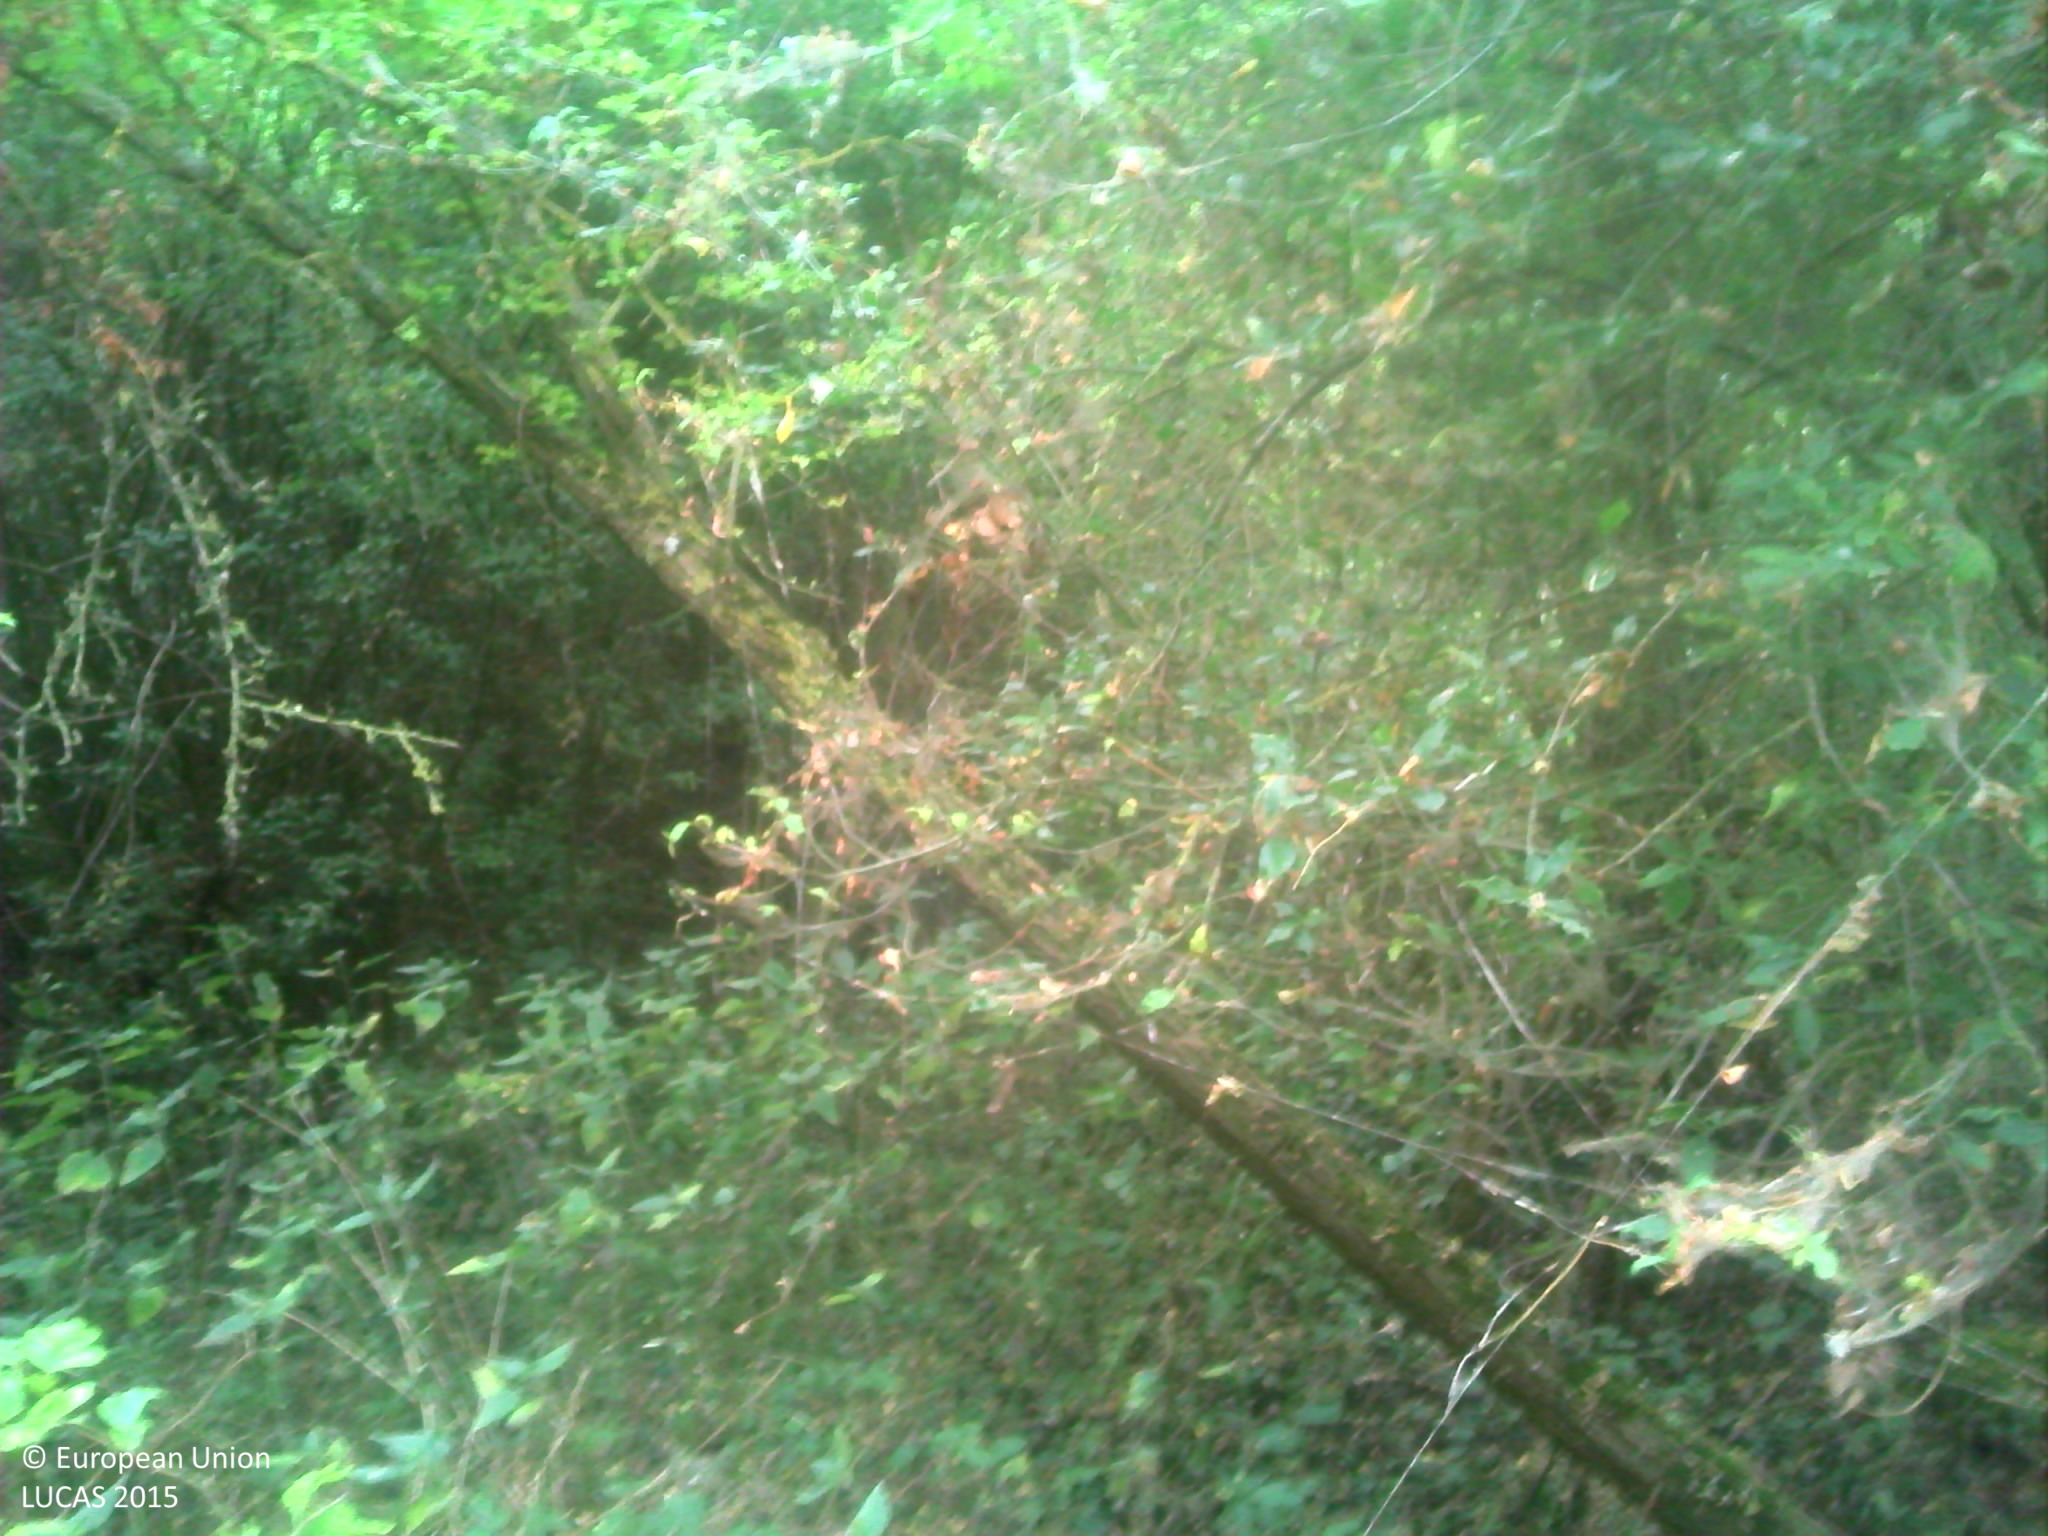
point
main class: Woodland
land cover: Broadleaved woodland
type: mesophytic deciduous forest
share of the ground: > 75 %
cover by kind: broadleaved forest trees 50 %, herbaceous plants 50 %
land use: Semi-natural and natural areas not in use
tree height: > 5 m
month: July
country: FR
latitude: 47.7167
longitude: 1.3062
